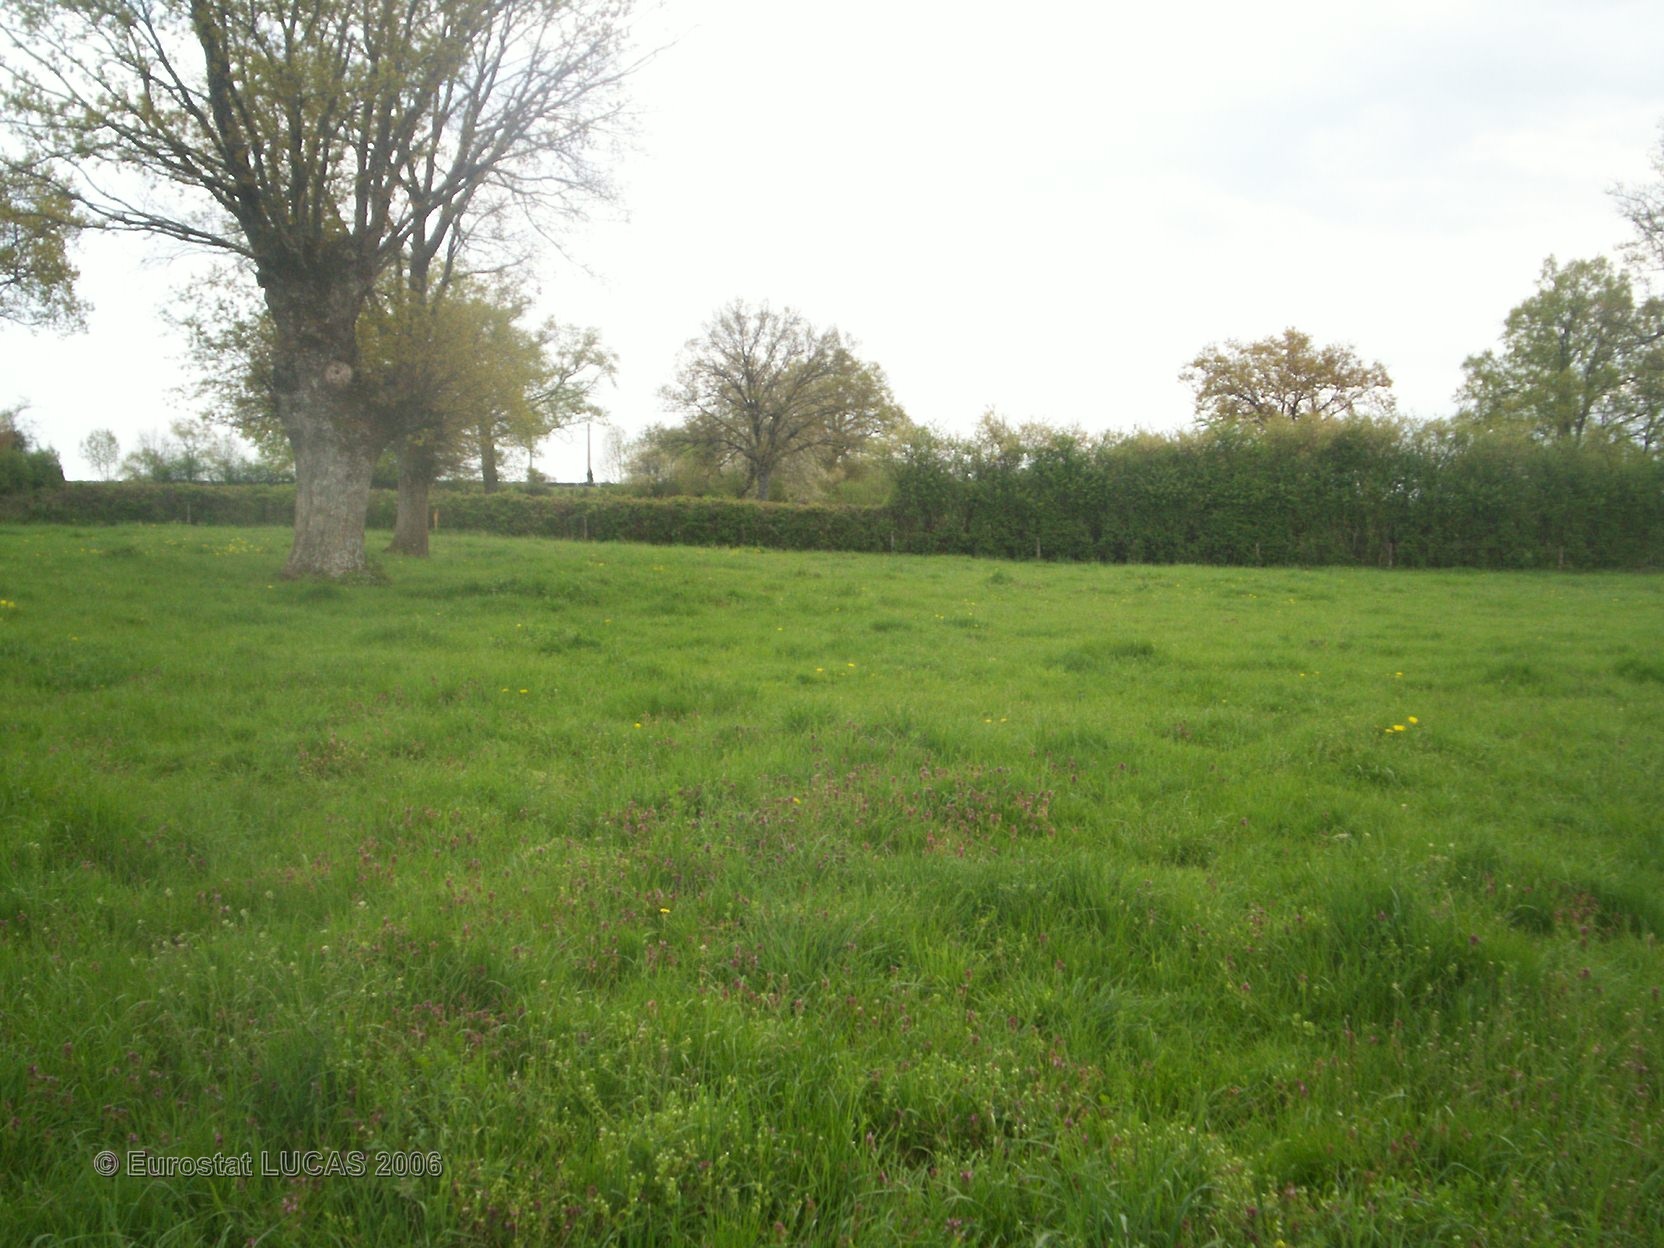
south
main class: Grassland
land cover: Grassland with sparse tree/shrub cover
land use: Agriculture (excluding fallow land and kitchen gardens)
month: May
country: FR
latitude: 46.4184
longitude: 3.1151
